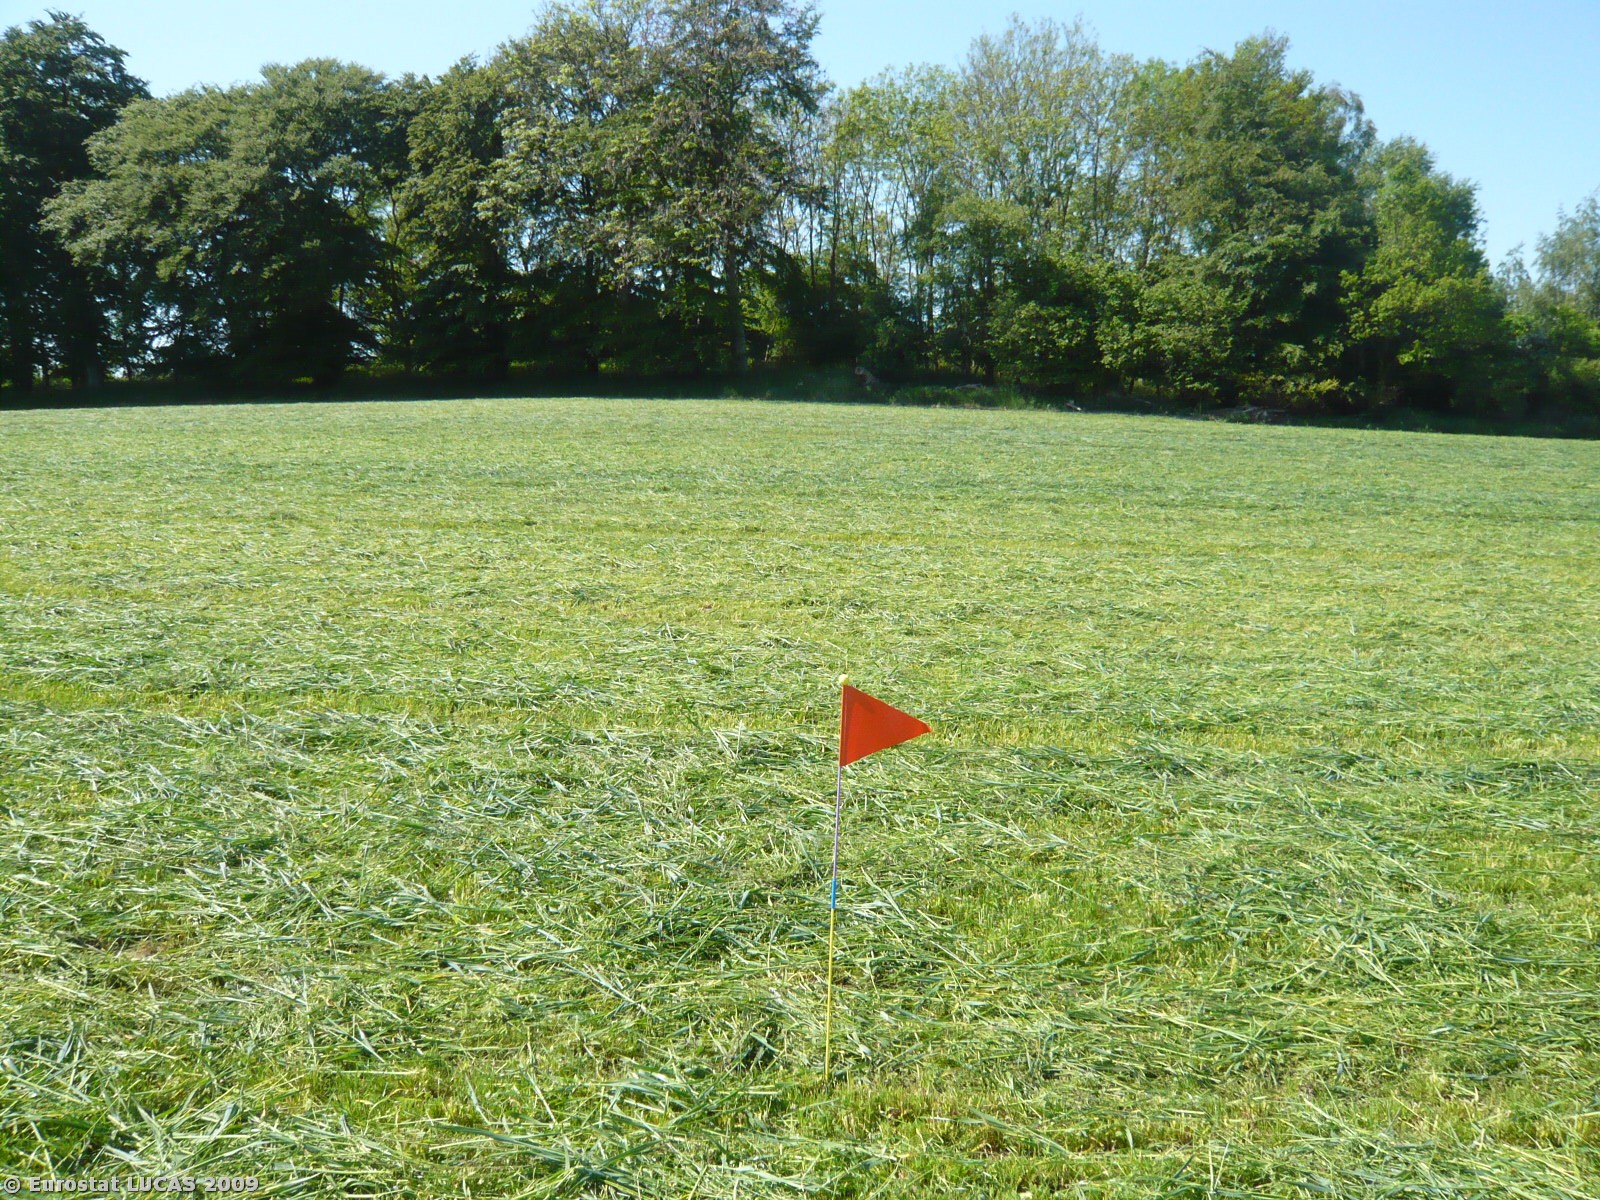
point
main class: Grassland
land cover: Grassland without tree/shrub cover
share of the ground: > 75 %
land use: Agriculture (excluding fallow land and kitchen gardens)
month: May
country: DK
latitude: 55.2774
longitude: 11.7145
